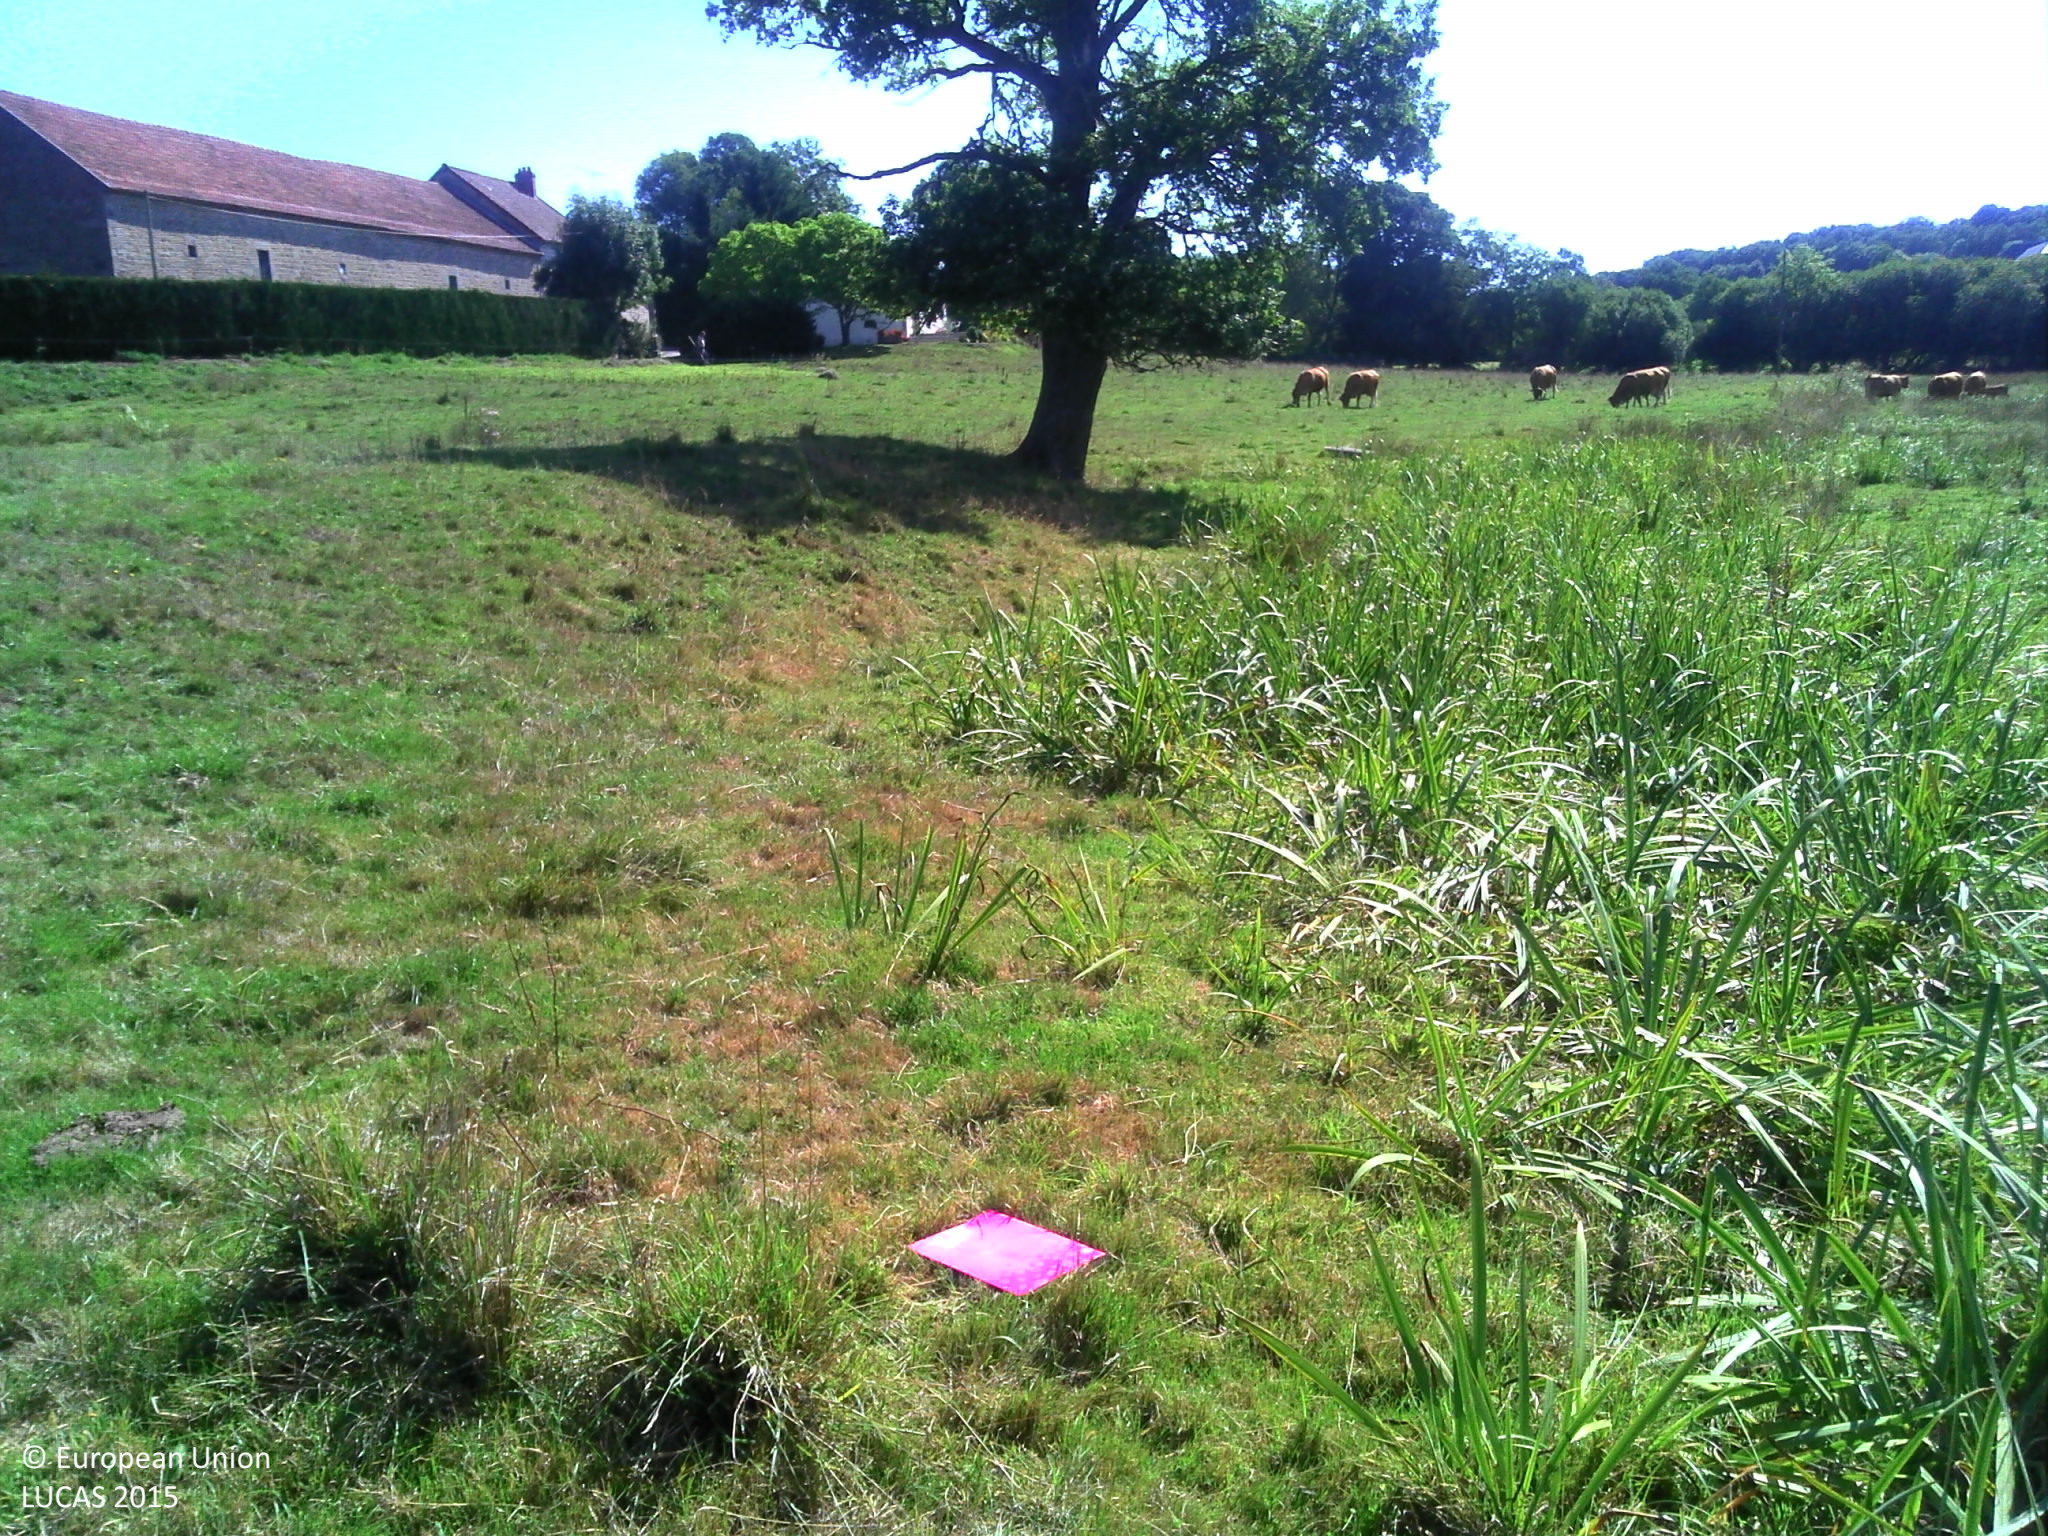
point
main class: Grassland
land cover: Grassland without tree/shrub cover
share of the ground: > 75 %
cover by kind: herbaceous plants 95 %, shrubs 5 %
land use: Agriculture (excluding fallow land and kitchen gardens)
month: August
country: FR
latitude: 45.9143
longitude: 2.3511
